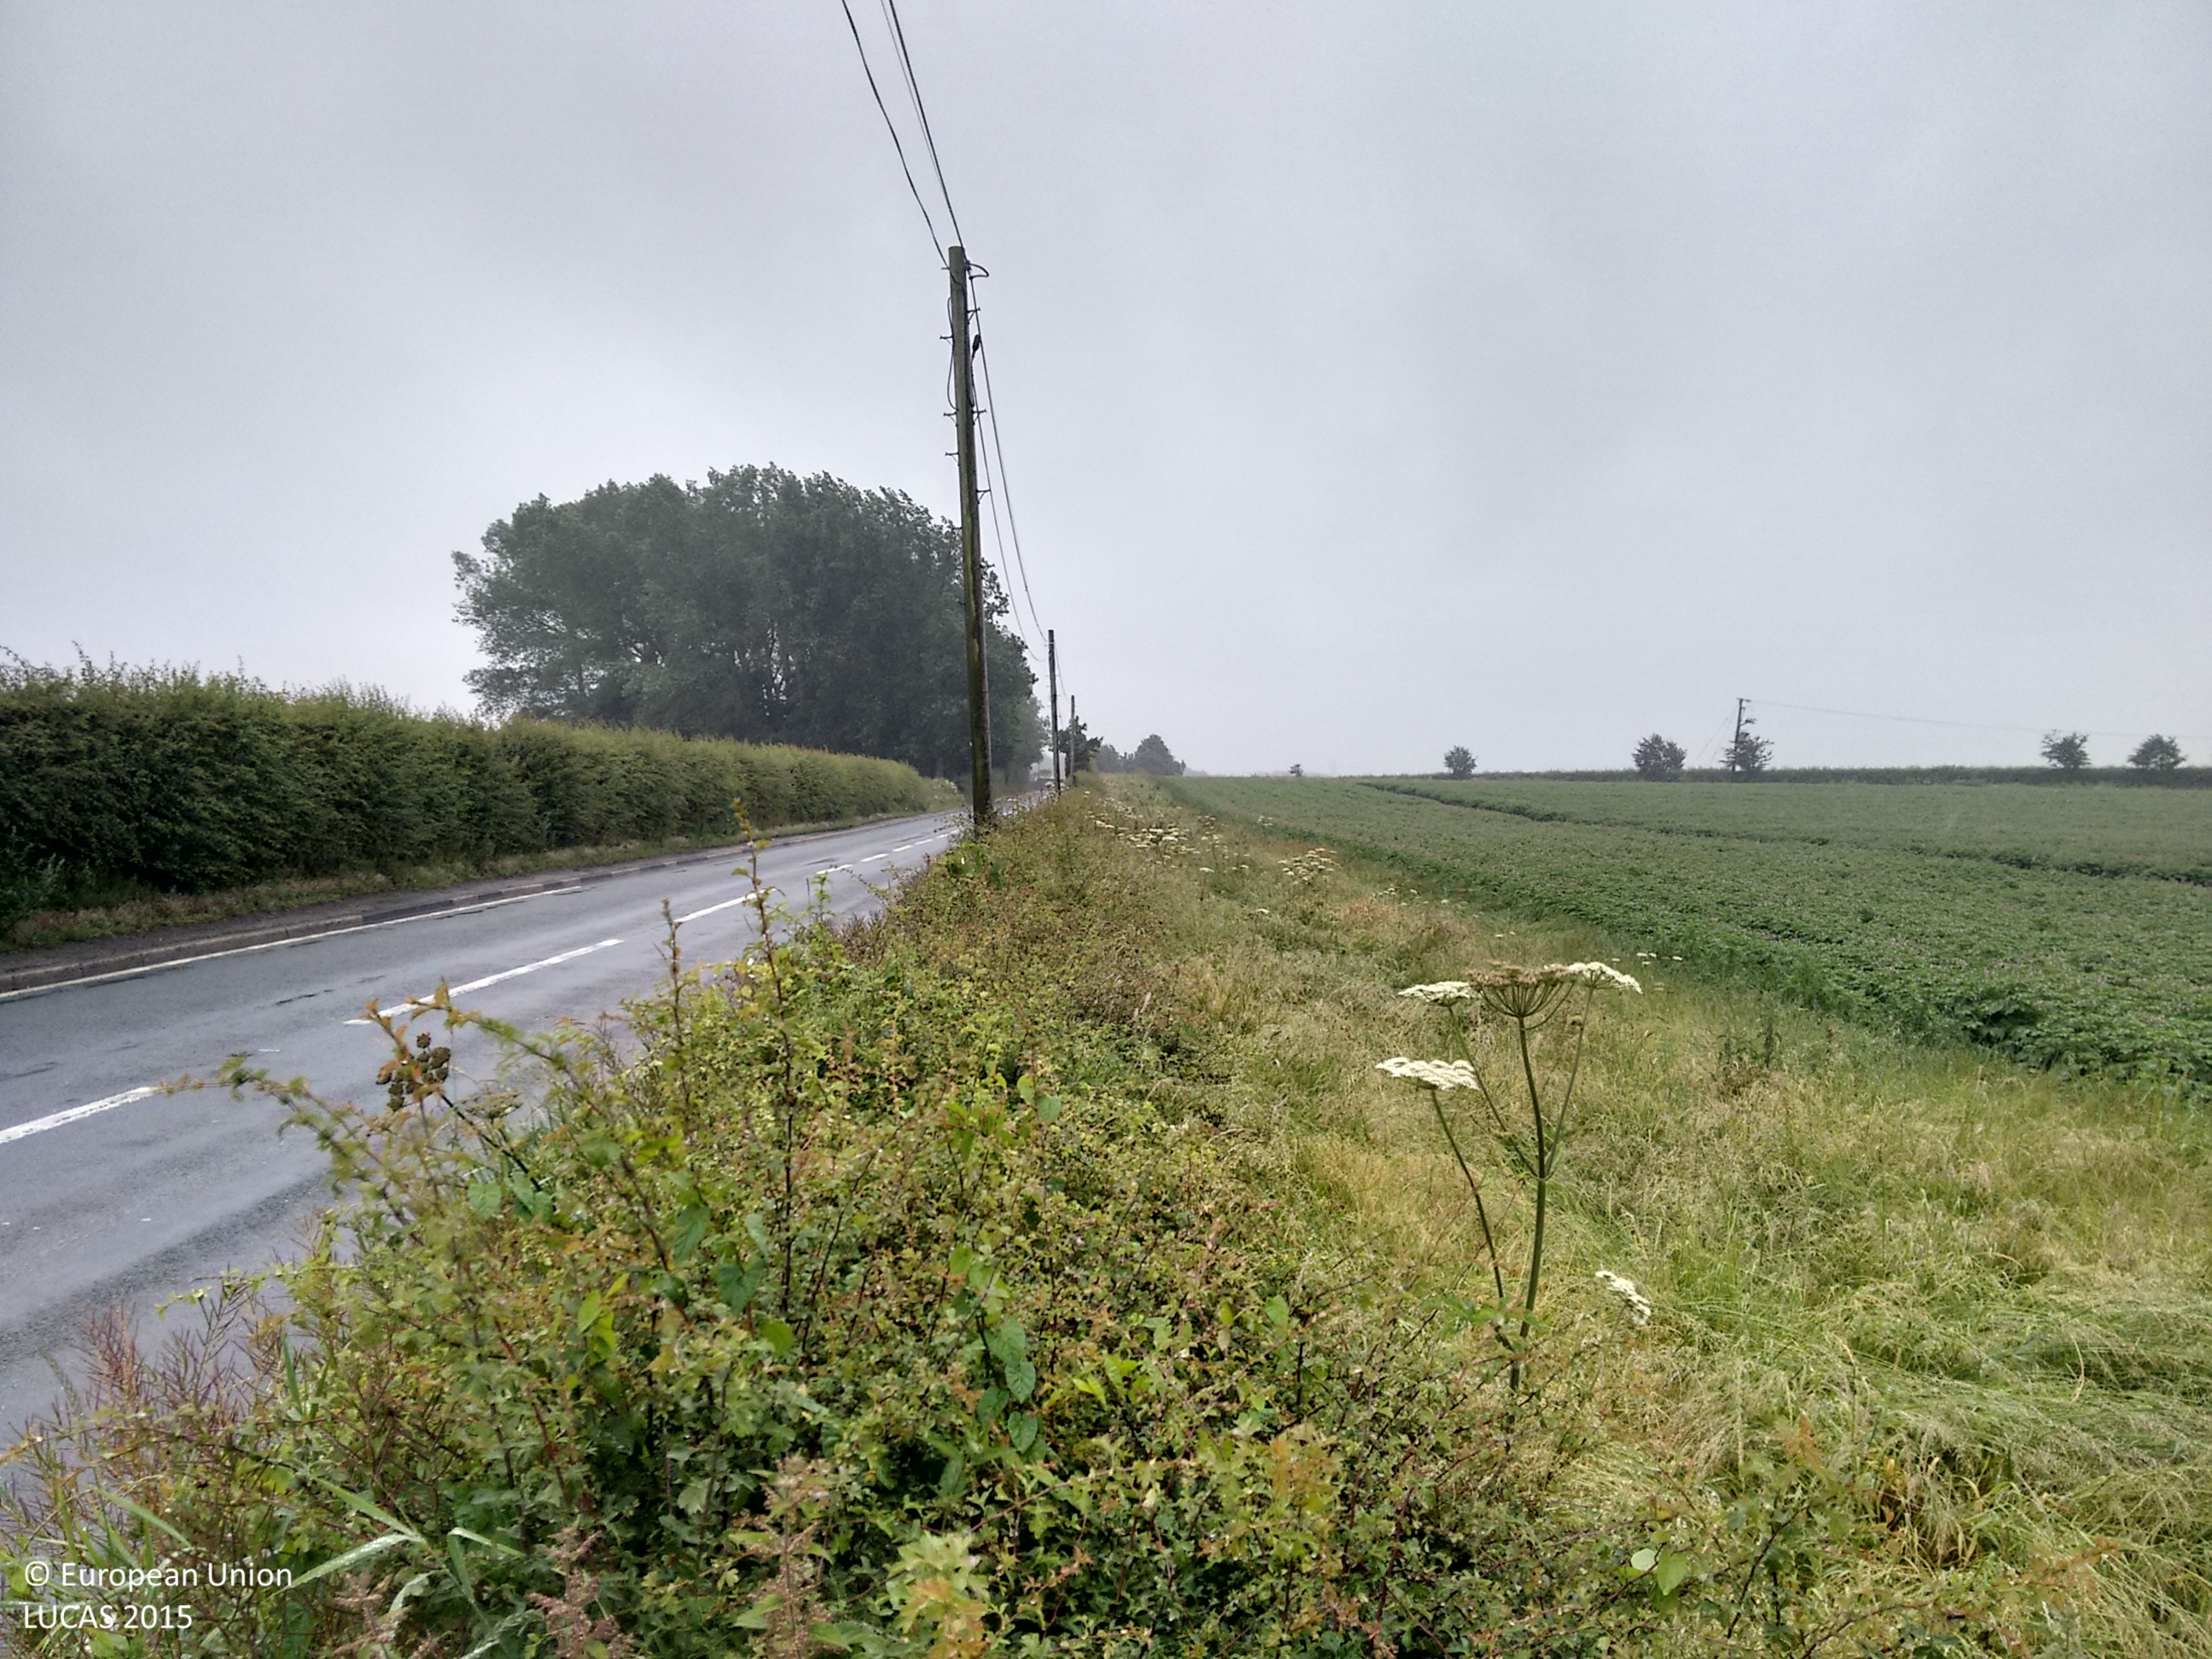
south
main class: Cropland
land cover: Potatoes
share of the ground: > 75 %
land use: Agriculture (excluding fallow land and kitchen gardens)
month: July
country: GB
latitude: 53.4836
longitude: -2.8046
